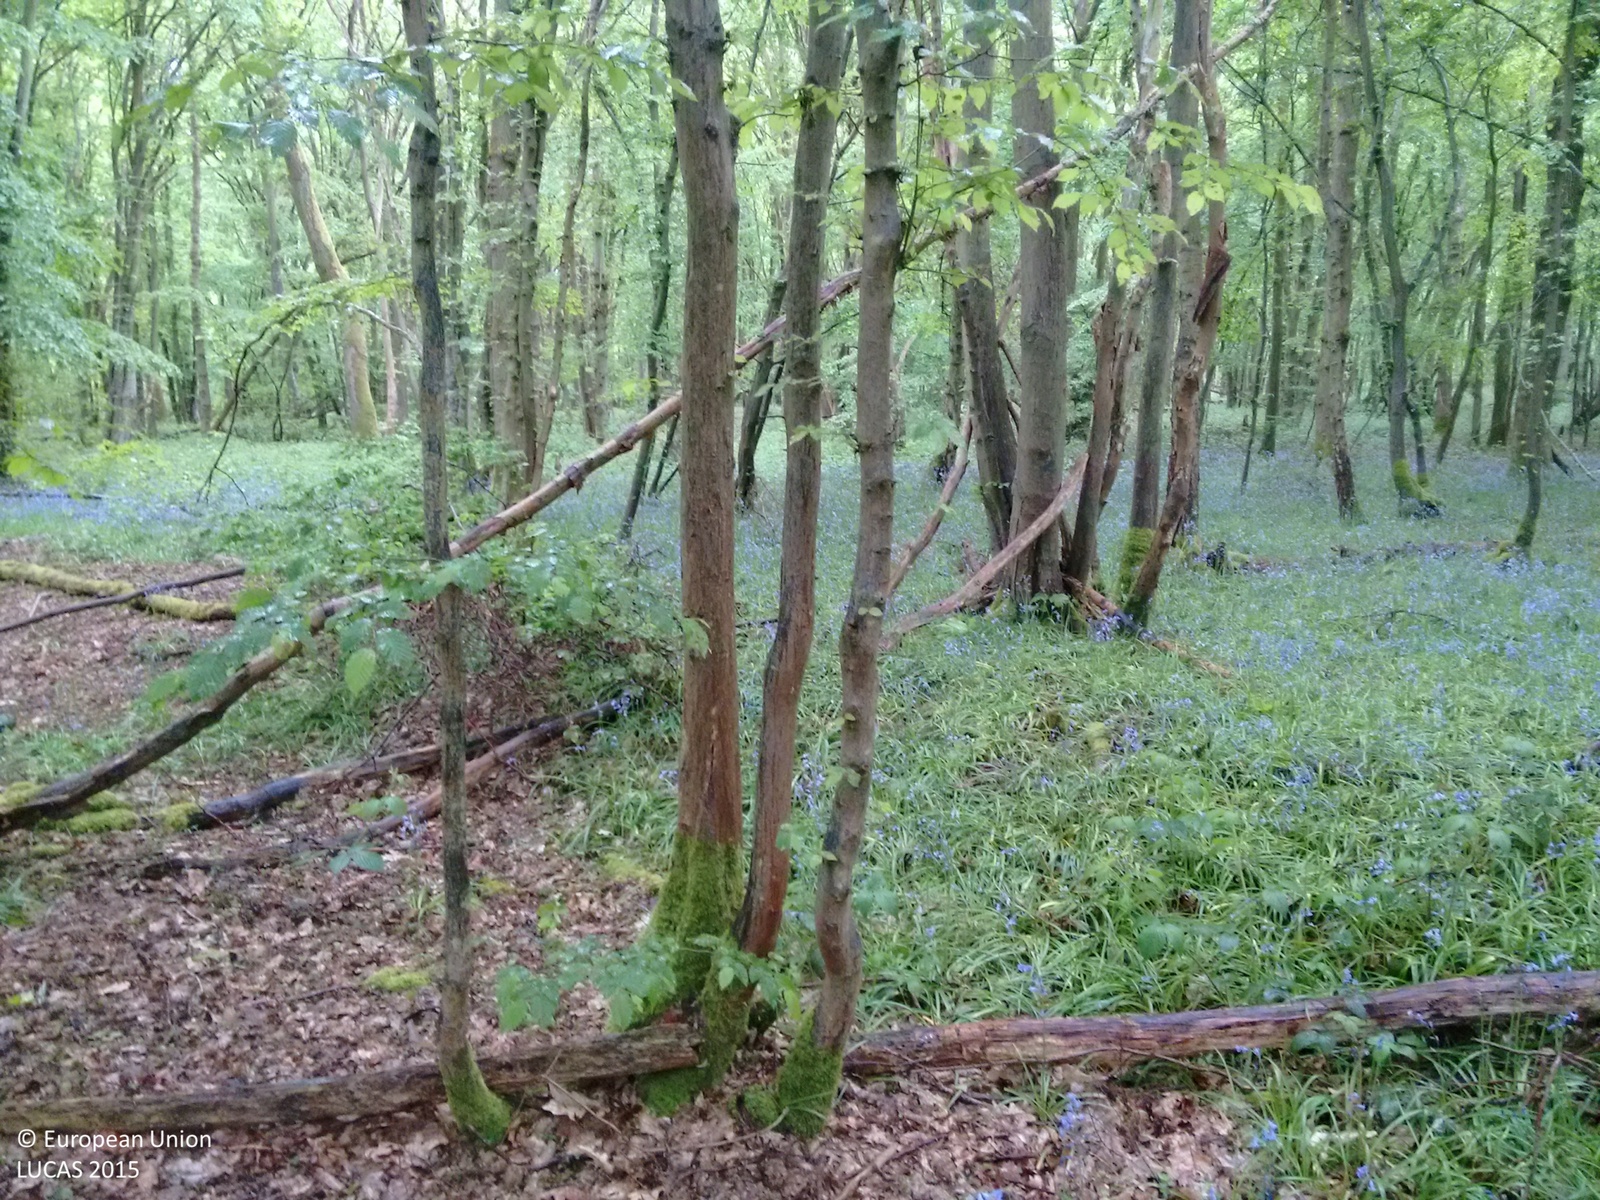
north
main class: Woodland
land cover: Broadleaved woodland
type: mesophytic deciduous forest
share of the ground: > 75 %
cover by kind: broadleaved forest trees 100 %
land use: Forestry
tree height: > 5 m
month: May
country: GB
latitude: 51.1628
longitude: 0.7221
